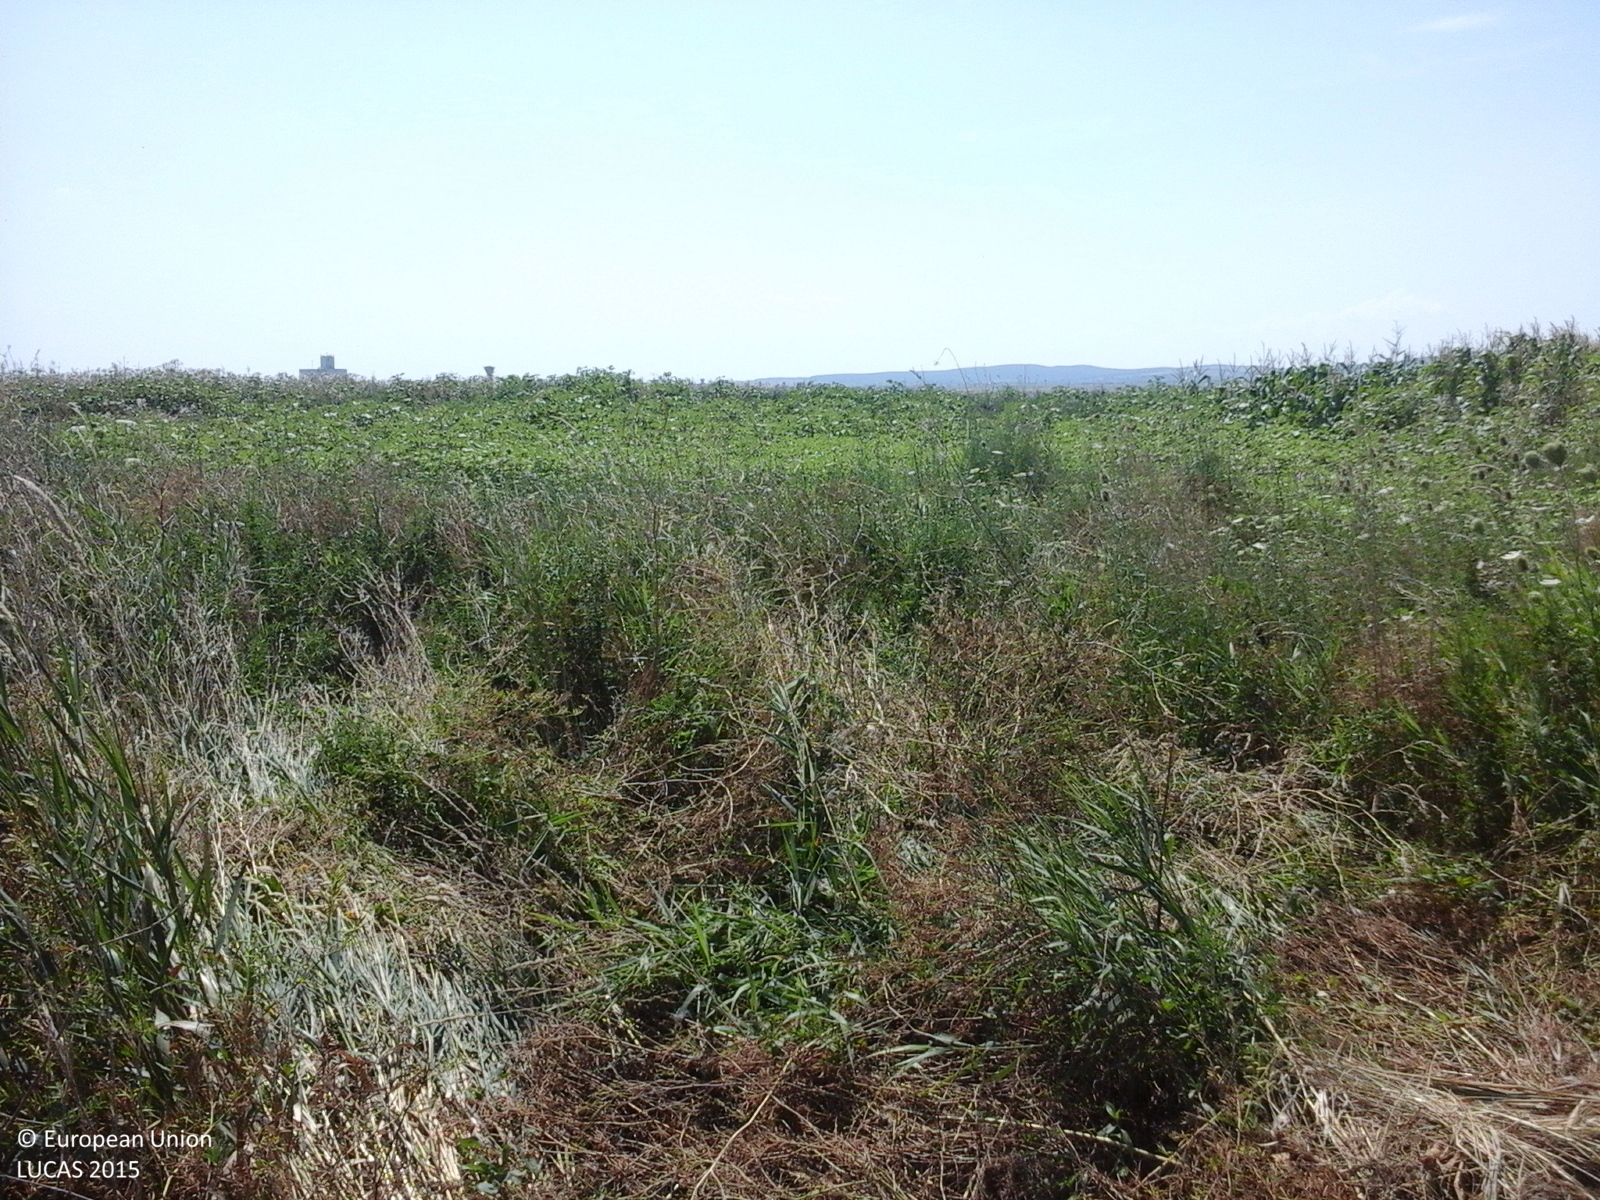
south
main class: Grassland
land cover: Spontaneously vegetated surfaces
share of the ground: > 75 %
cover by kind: herbaceous plants 100 %
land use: Fallow land
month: August
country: RO
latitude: 46.2269
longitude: 27.1210
